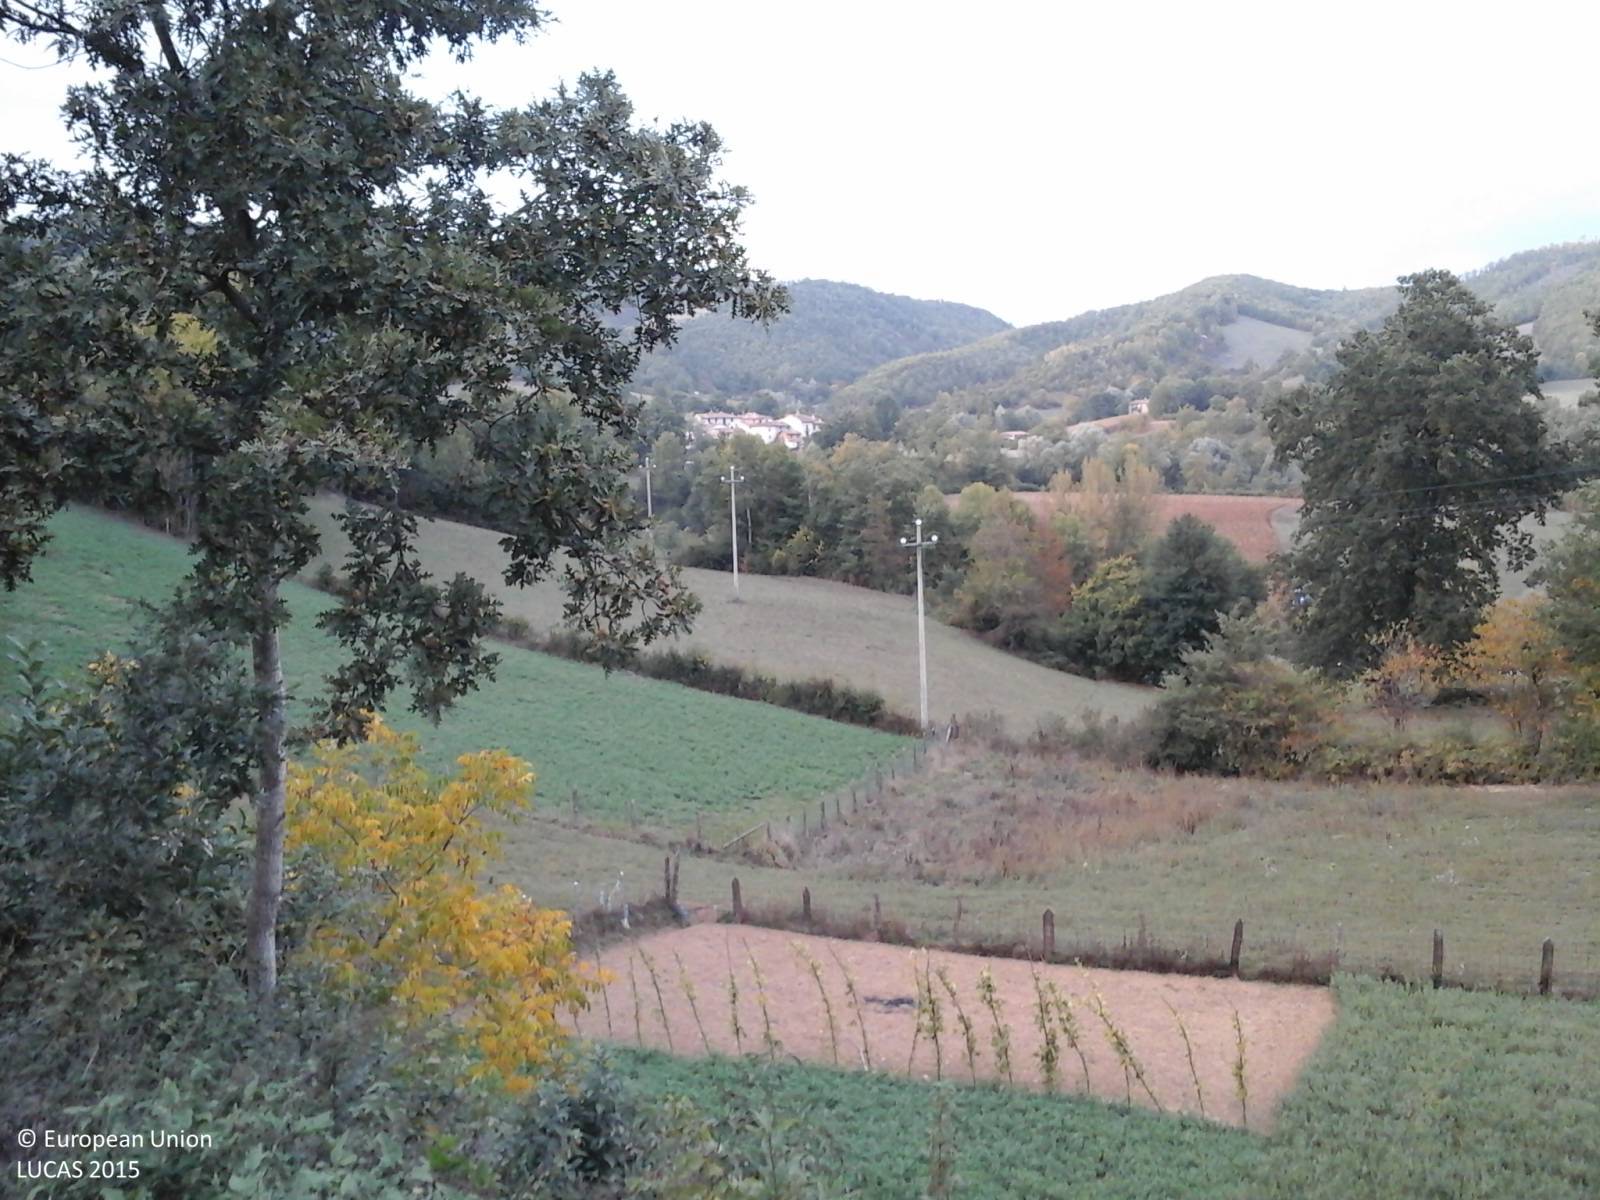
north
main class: Woodland
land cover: Broadleaved woodland
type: thermophilous deciduous forest
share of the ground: > 75 %
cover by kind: broadleaved forest trees 100 %
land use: Forestry
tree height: > 5 m
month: October
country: IT
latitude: 42.6562
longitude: 13.2472
